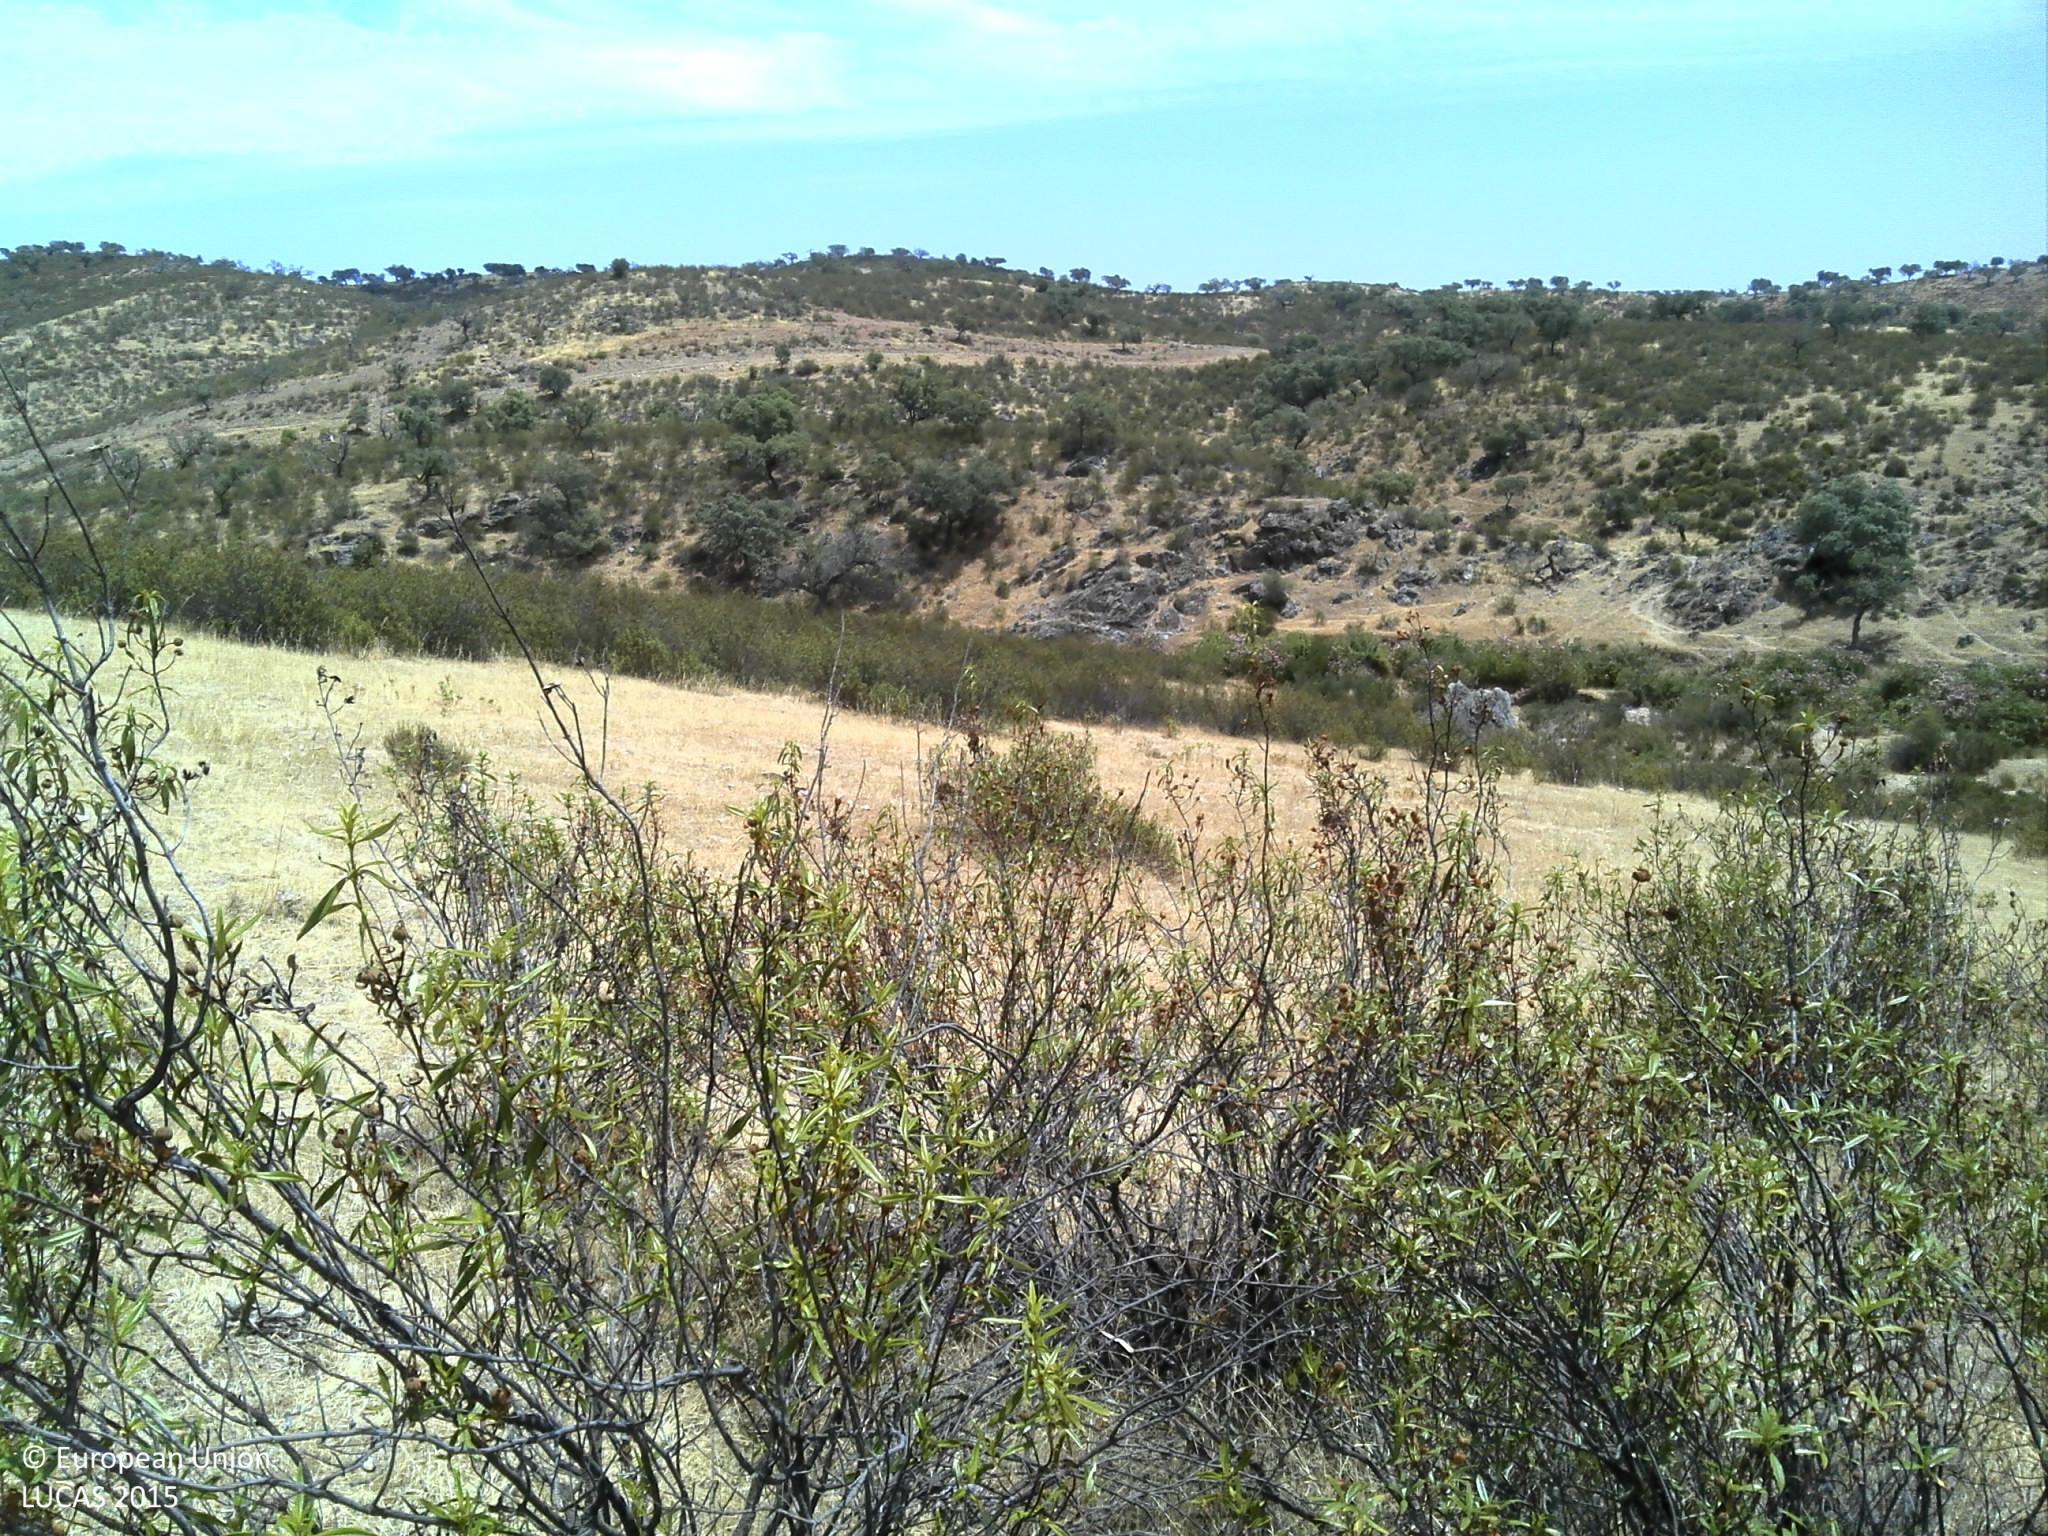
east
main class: Shrubland
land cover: Shrubland without tree cover
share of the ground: 50 - 75 %
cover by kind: shrubs 80 %, herbaceous plants 20 %
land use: Abandoned areas
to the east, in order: Shrubland without tree cover; Grassland without tree/shrub cover; Shrubland without tree cover; Rocks and stones; Shrubland without tree cover; Inland fresh running water; Shrubland without tree cover; Broadleaved woodland; Shrubland with sparse tree cover; Rocks and stones; Shrubland with sparse tree cover; Inland fresh running water; Shrubland without tree cover
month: July
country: PT
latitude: 38.1075
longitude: -7.2015
